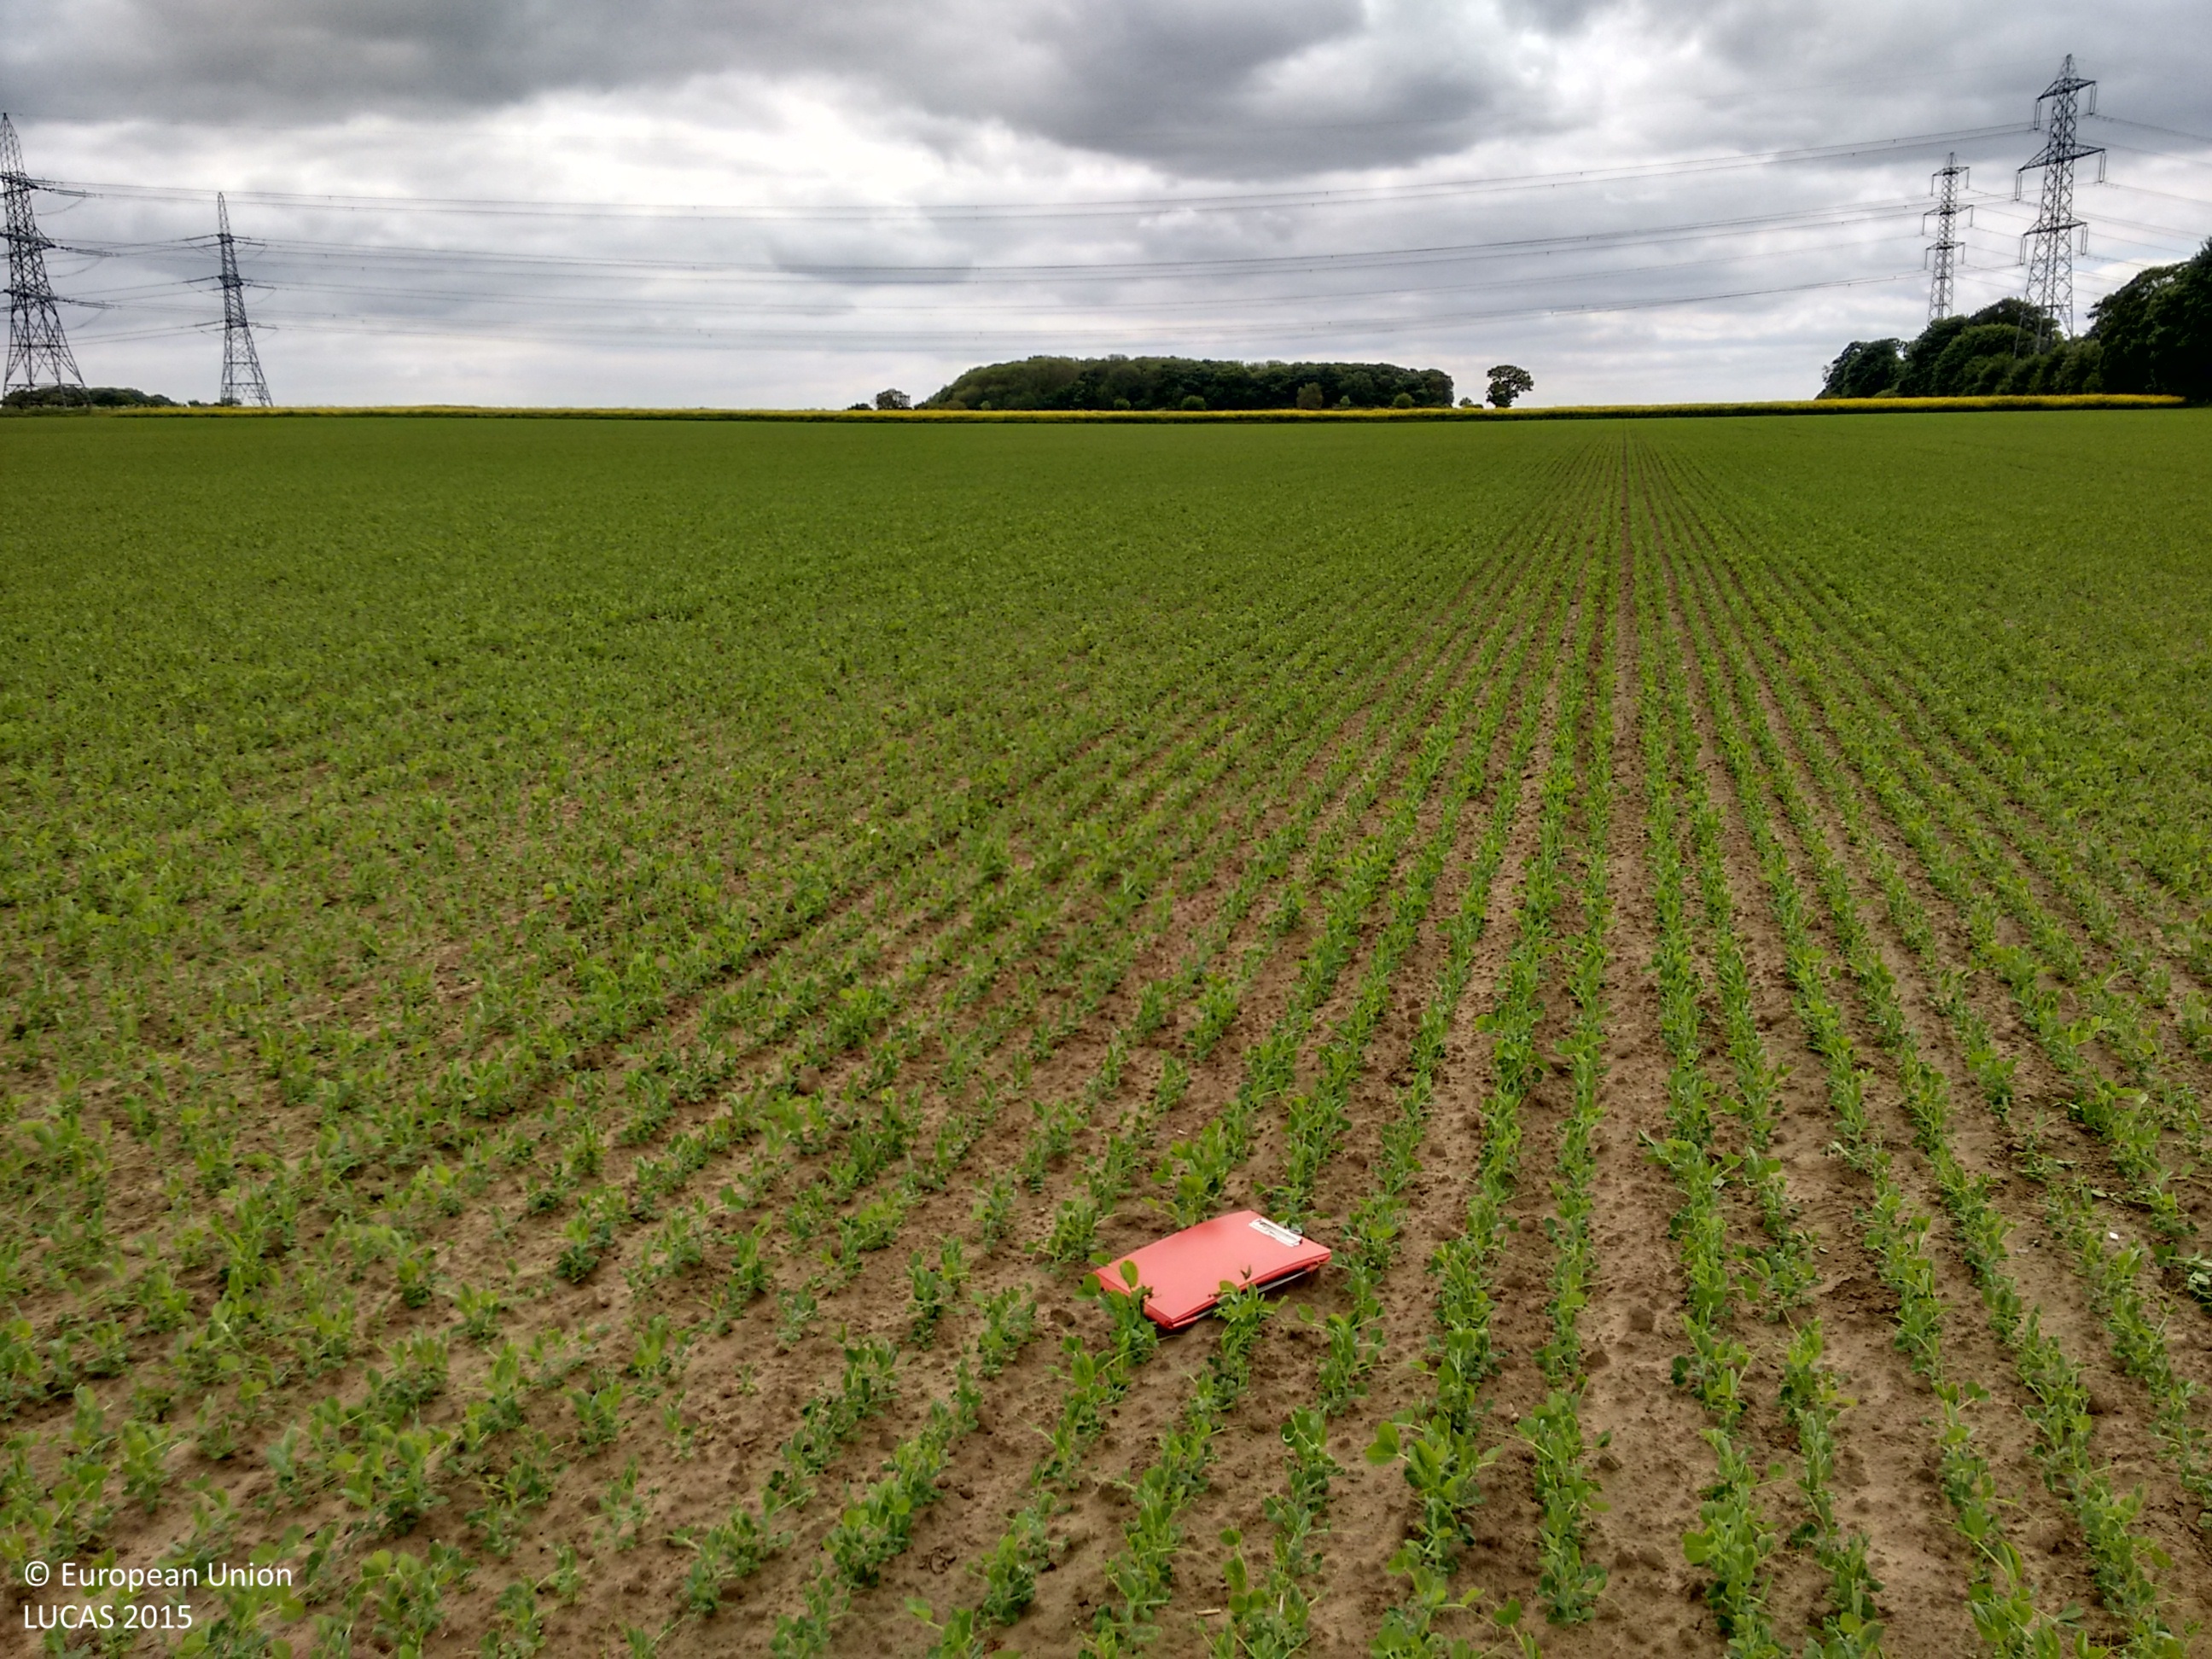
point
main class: Cropland
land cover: Dry pulses
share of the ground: 25 - 50 %
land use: Agriculture (excluding fallow land and kitchen gardens)
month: May
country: GB
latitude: 53.6720
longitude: -0.6803
